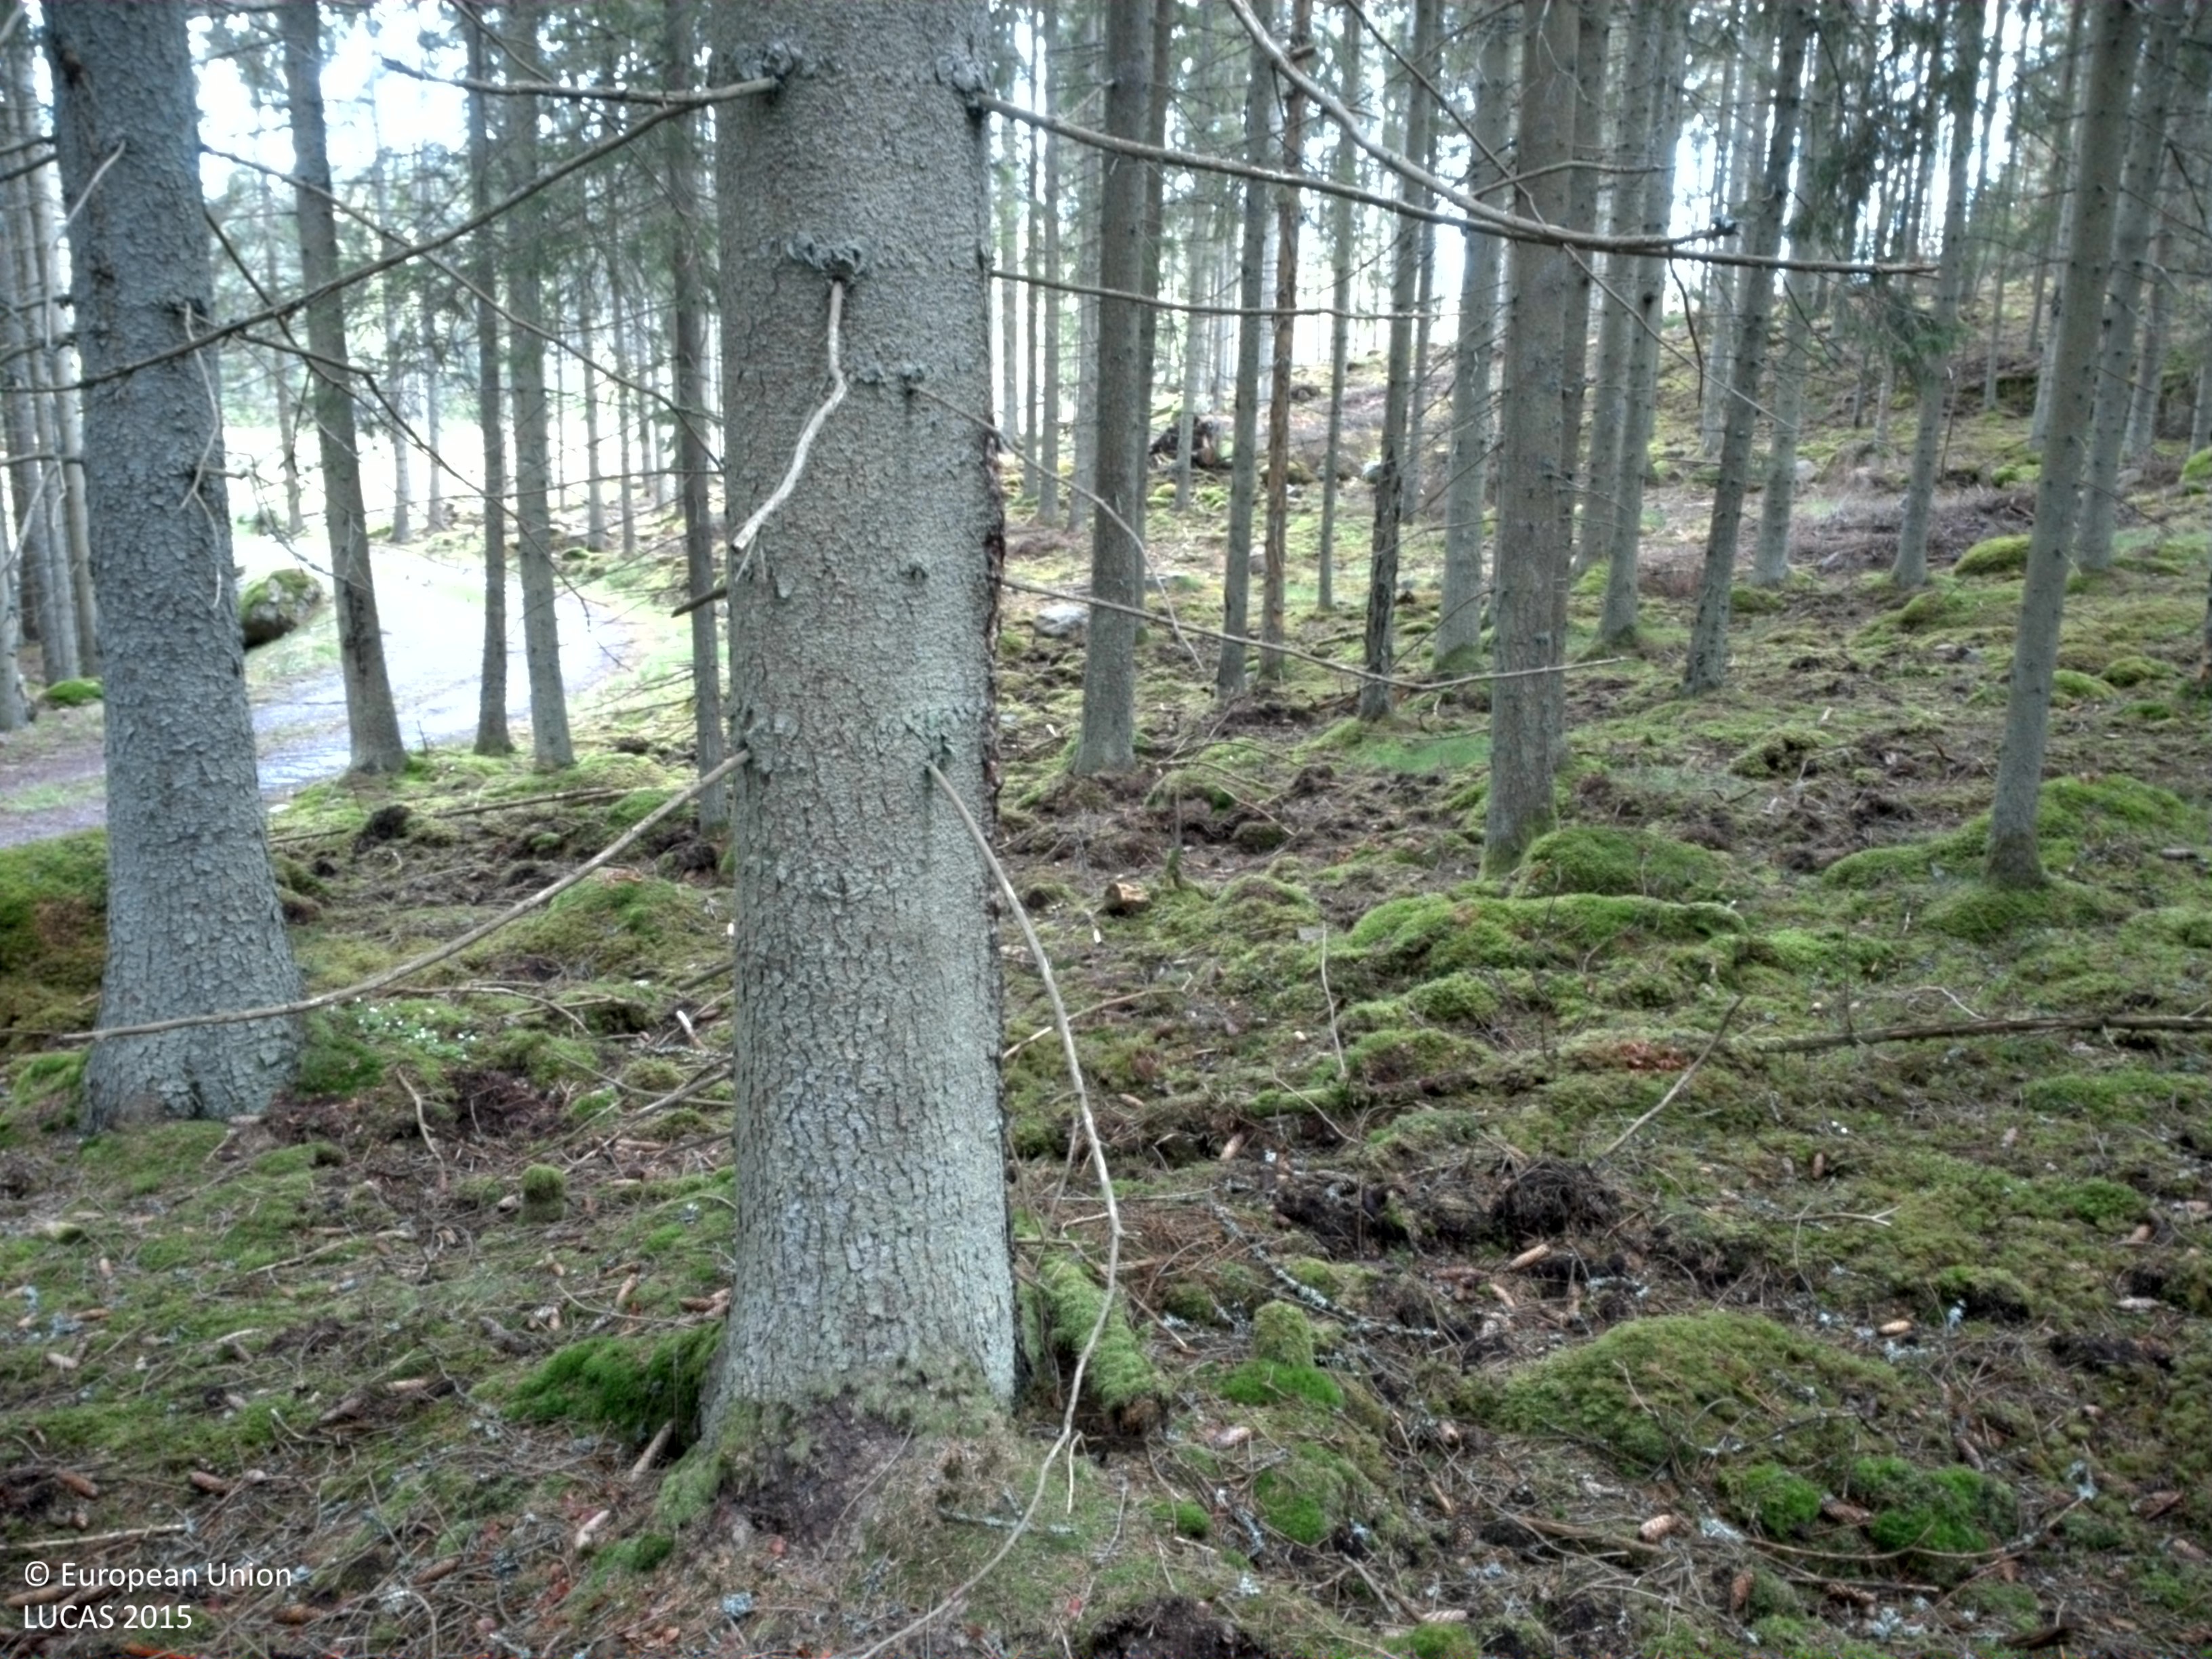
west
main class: Woodland
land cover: Spruce dominated coniferous woodland
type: boreal forest
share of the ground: > 75 %
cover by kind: coniferous forest trees 95 %, lichens and mosses 5 %
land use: Forestry
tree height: > 5 m
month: May
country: SE
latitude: 56.5036
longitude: 15.4741
